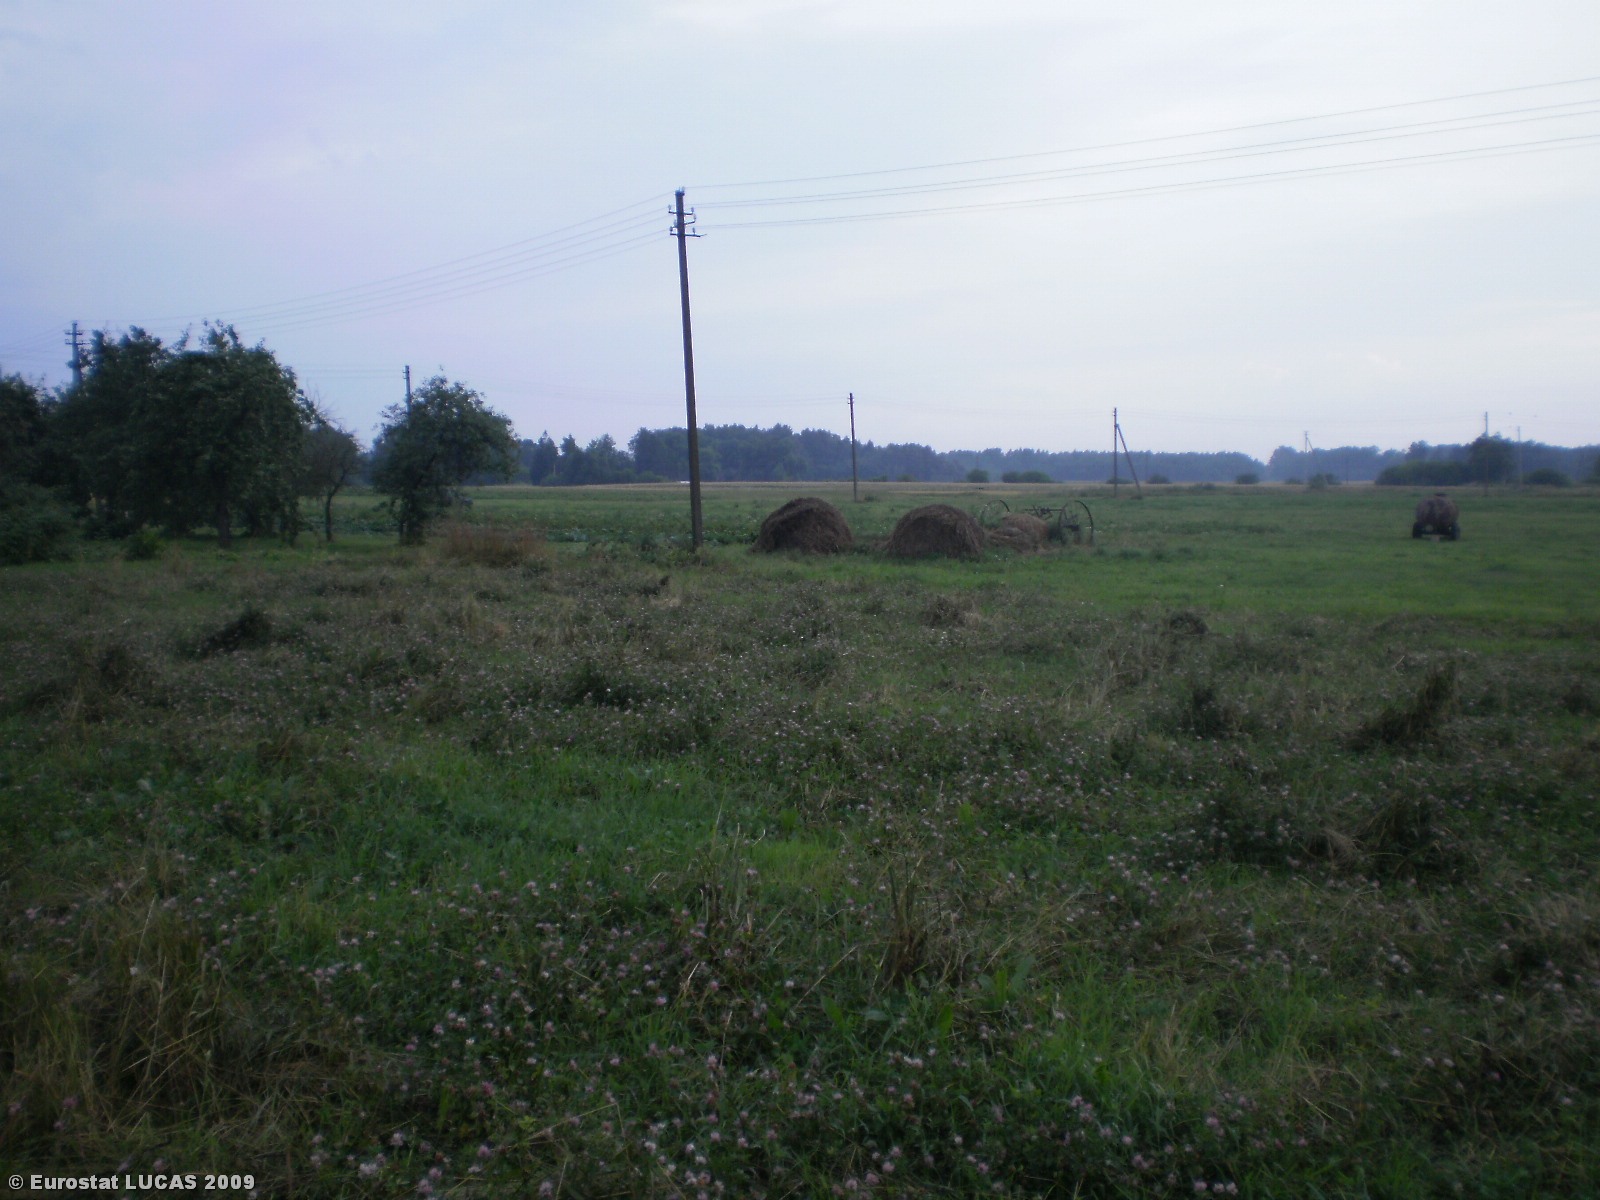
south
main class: Cropland
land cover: Clovers
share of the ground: > 75 %
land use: Agriculture (excluding fallow land and kitchen gardens)
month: July
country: LT
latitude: 55.8656
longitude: 24.8558
